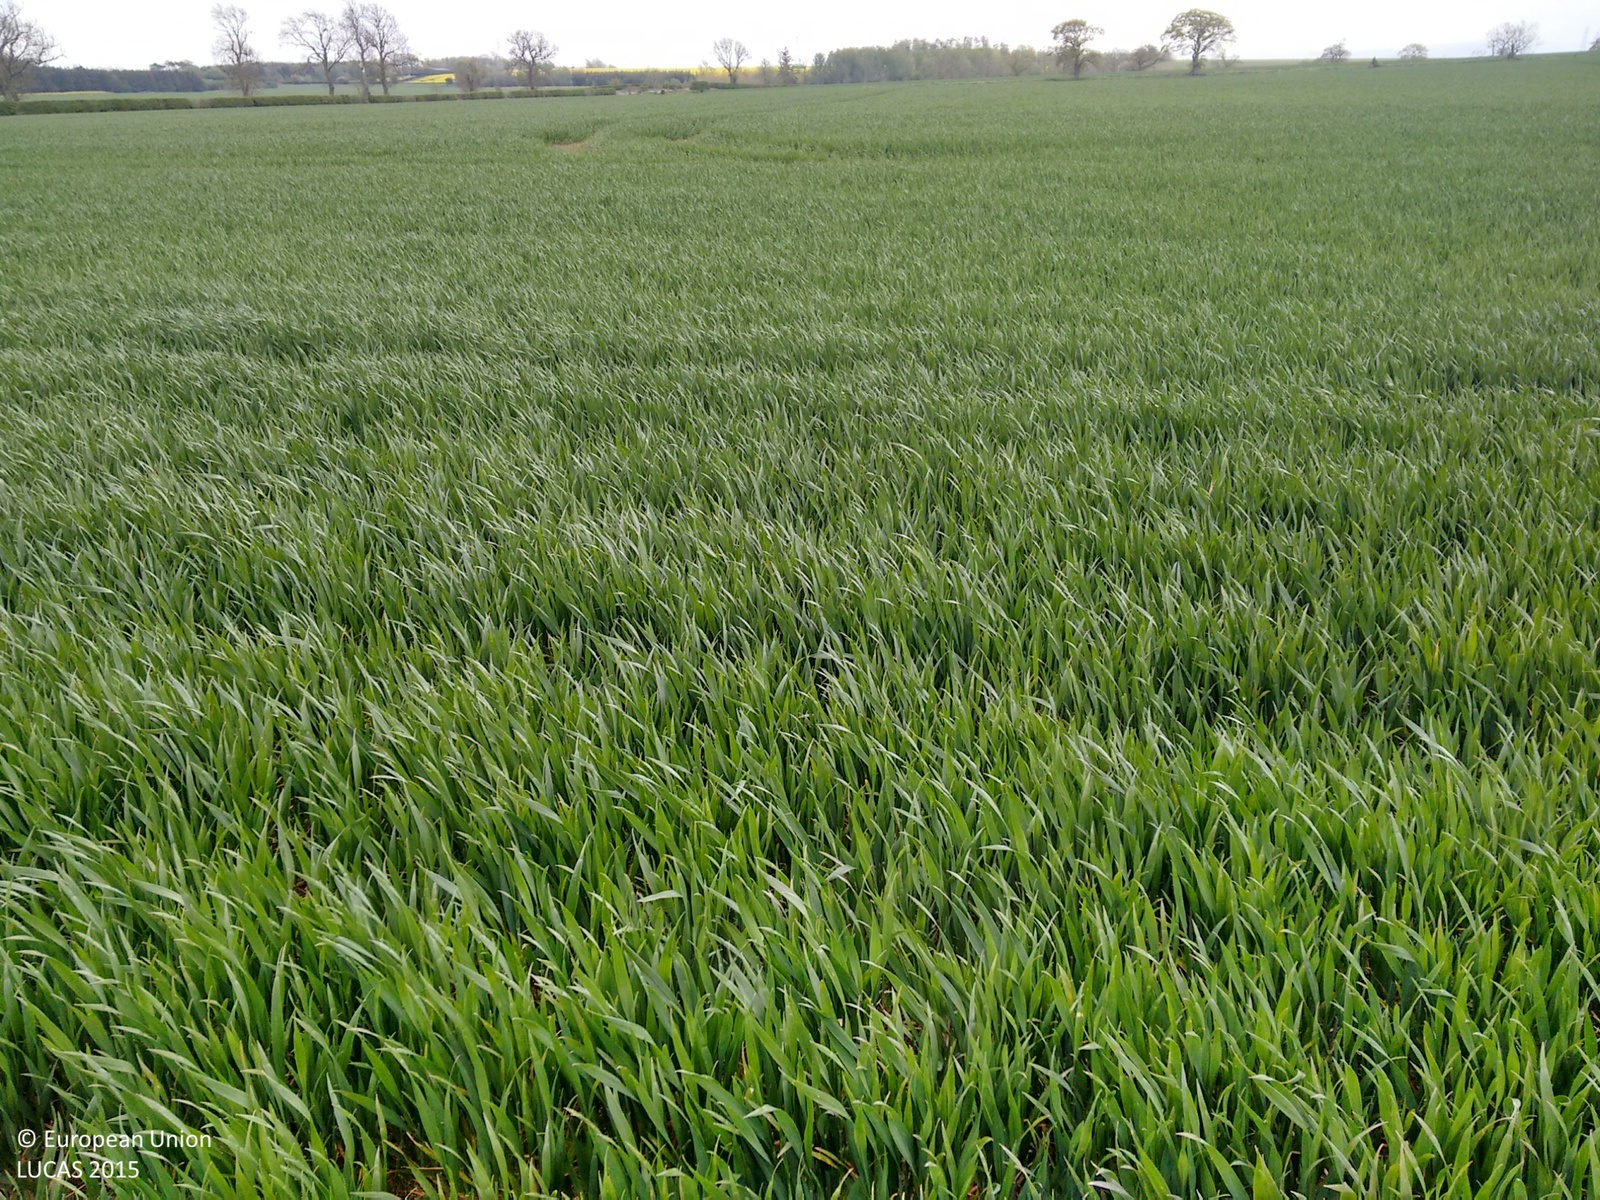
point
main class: Cropland
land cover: Common wheat
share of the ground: > 75 %
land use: Agriculture (excluding fallow land and kitchen gardens)
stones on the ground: < 10 %
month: May
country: GB
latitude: 55.7031
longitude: -2.2939
